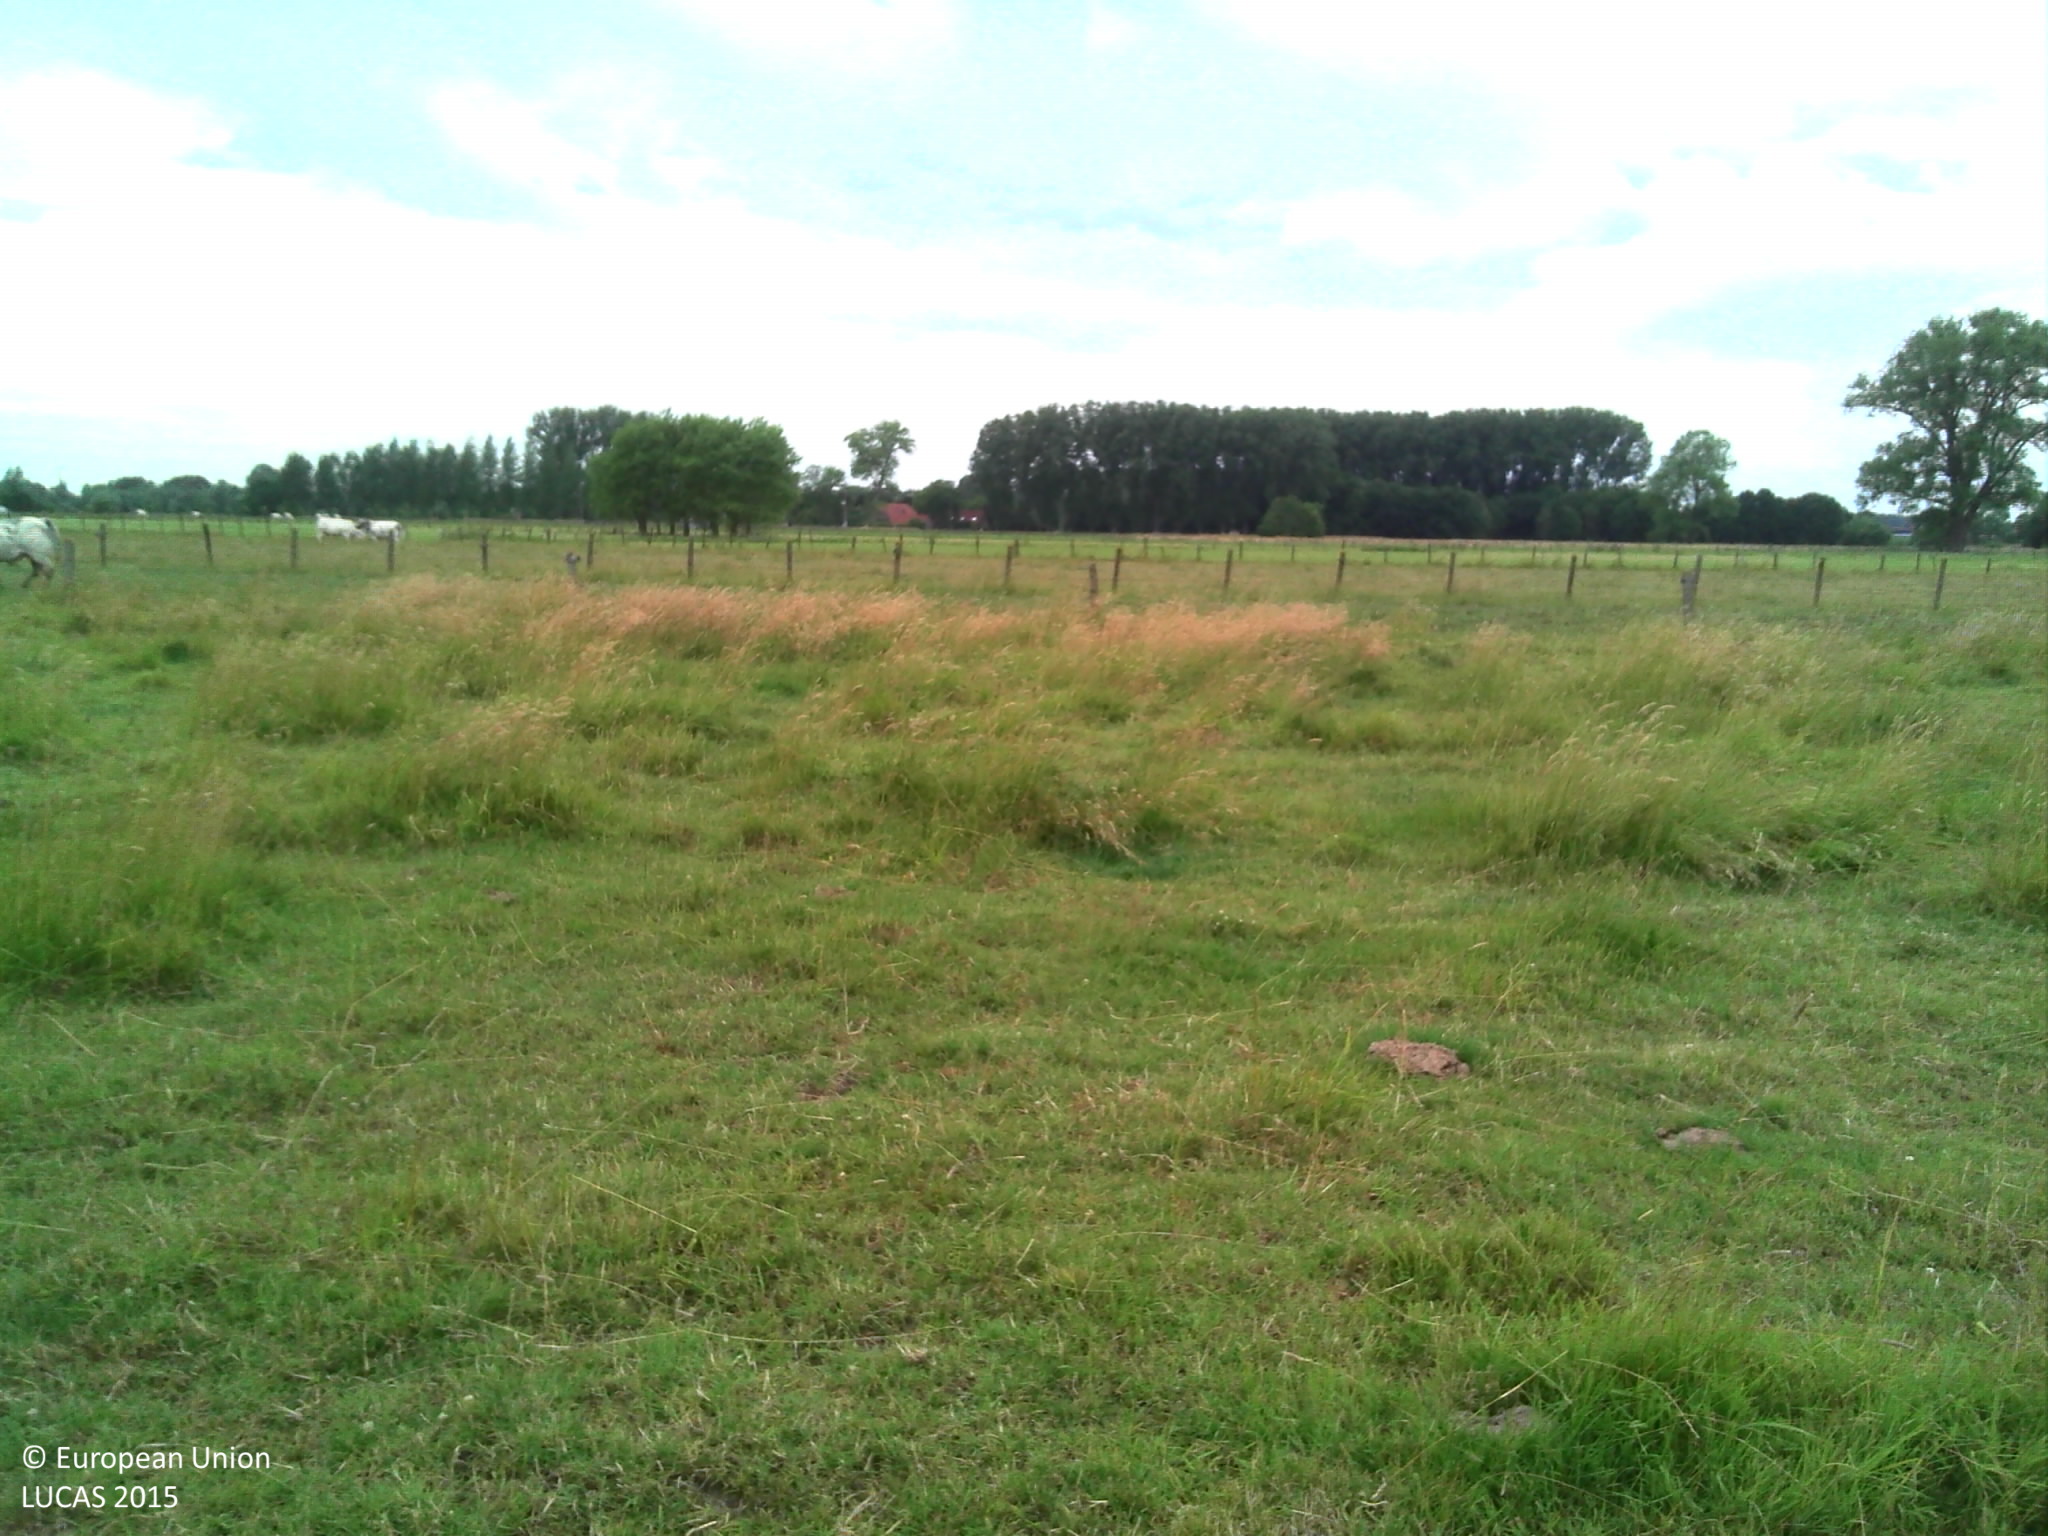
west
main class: Grassland
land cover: Grassland without tree/shrub cover
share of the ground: > 75 %
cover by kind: herbaceous plants 100 %
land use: Agriculture (excluding fallow land and kitchen gardens)
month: June
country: BE
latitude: 50.9946
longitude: 3.5666
